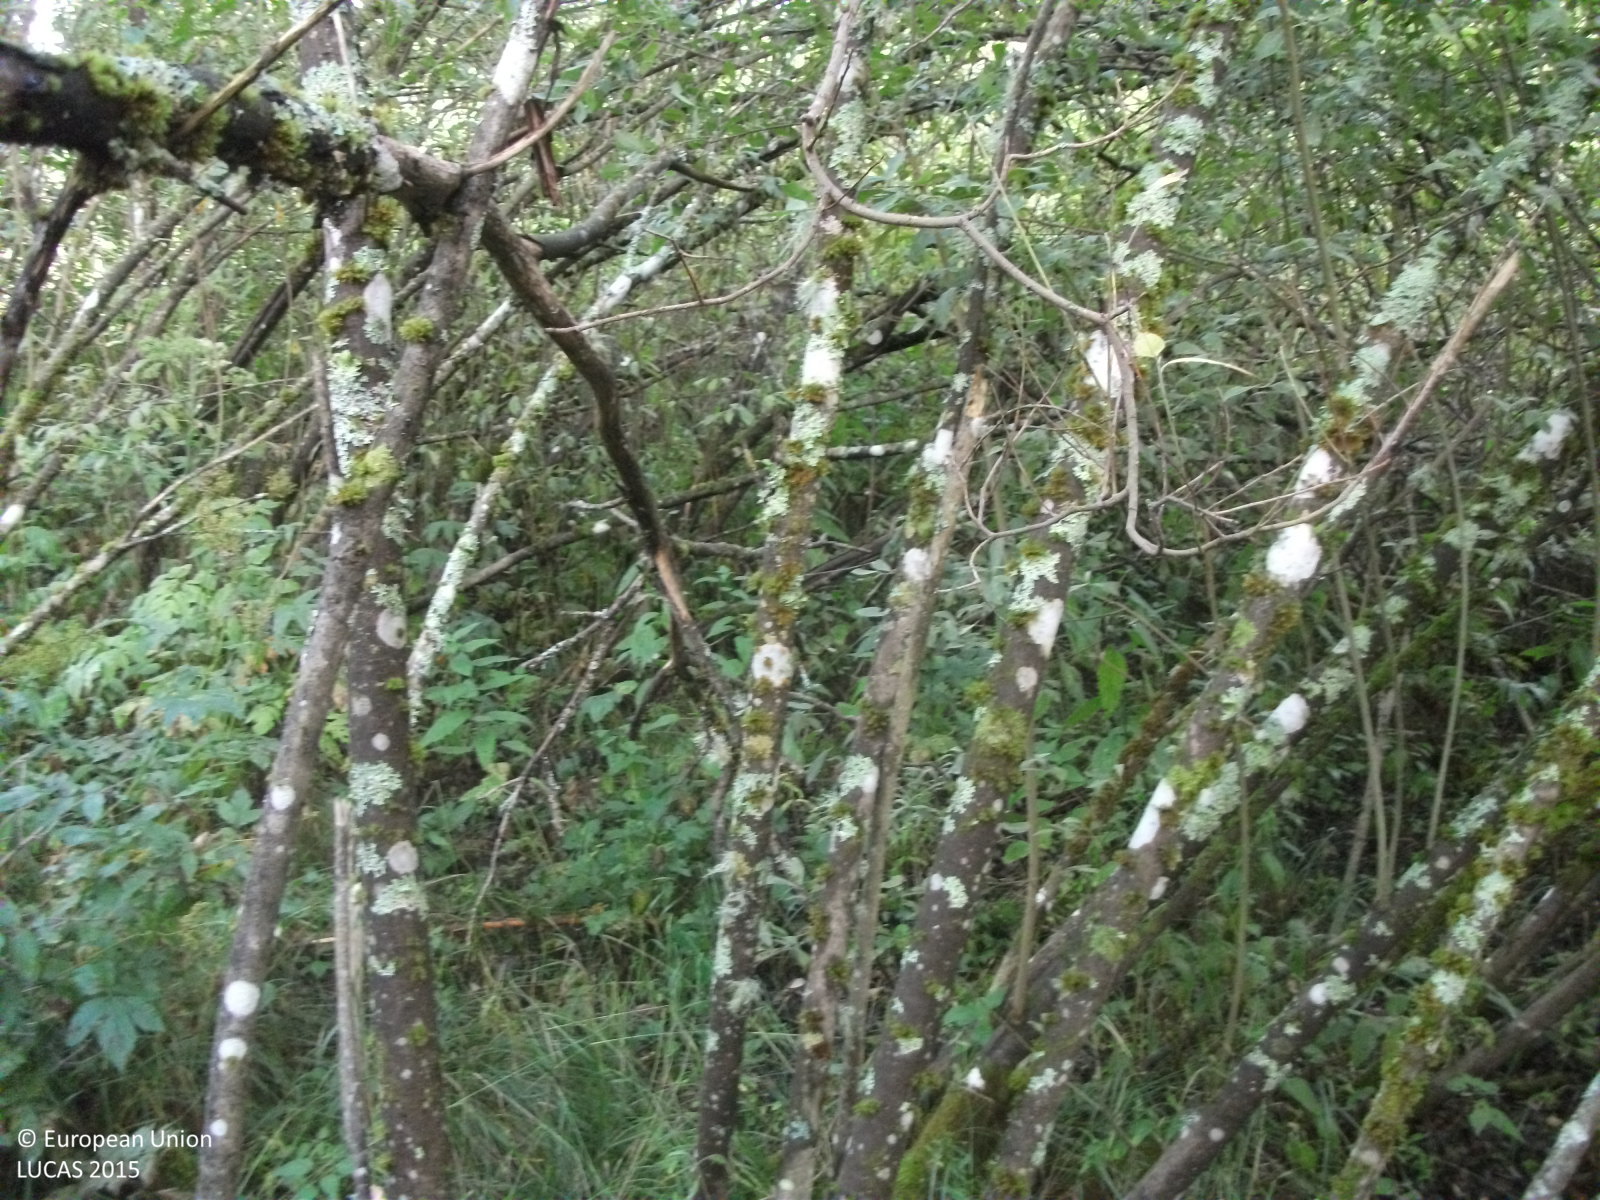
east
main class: Woodland
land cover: Broadleaved woodland
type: mire and swamp forests
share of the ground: 50 - 75 %
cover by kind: broadleaved forest trees 65 %, shrubs 25 %, herbaceous plants 10 %
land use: Semi-natural and natural areas not in use
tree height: > 5 m
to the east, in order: Broadleaved woodland; Spontaneously vegetated surfaces; Broadleaved woodland; Ditches and canals; Broadleaved woodland; Spontaneously vegetated surfaces; Broadleaved woodland; Spontaneously vegetated surfaces; Inland fresh running water; Inland marshes; Broadleaved woodland
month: September
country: LV
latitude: 57.6335
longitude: 24.7851
